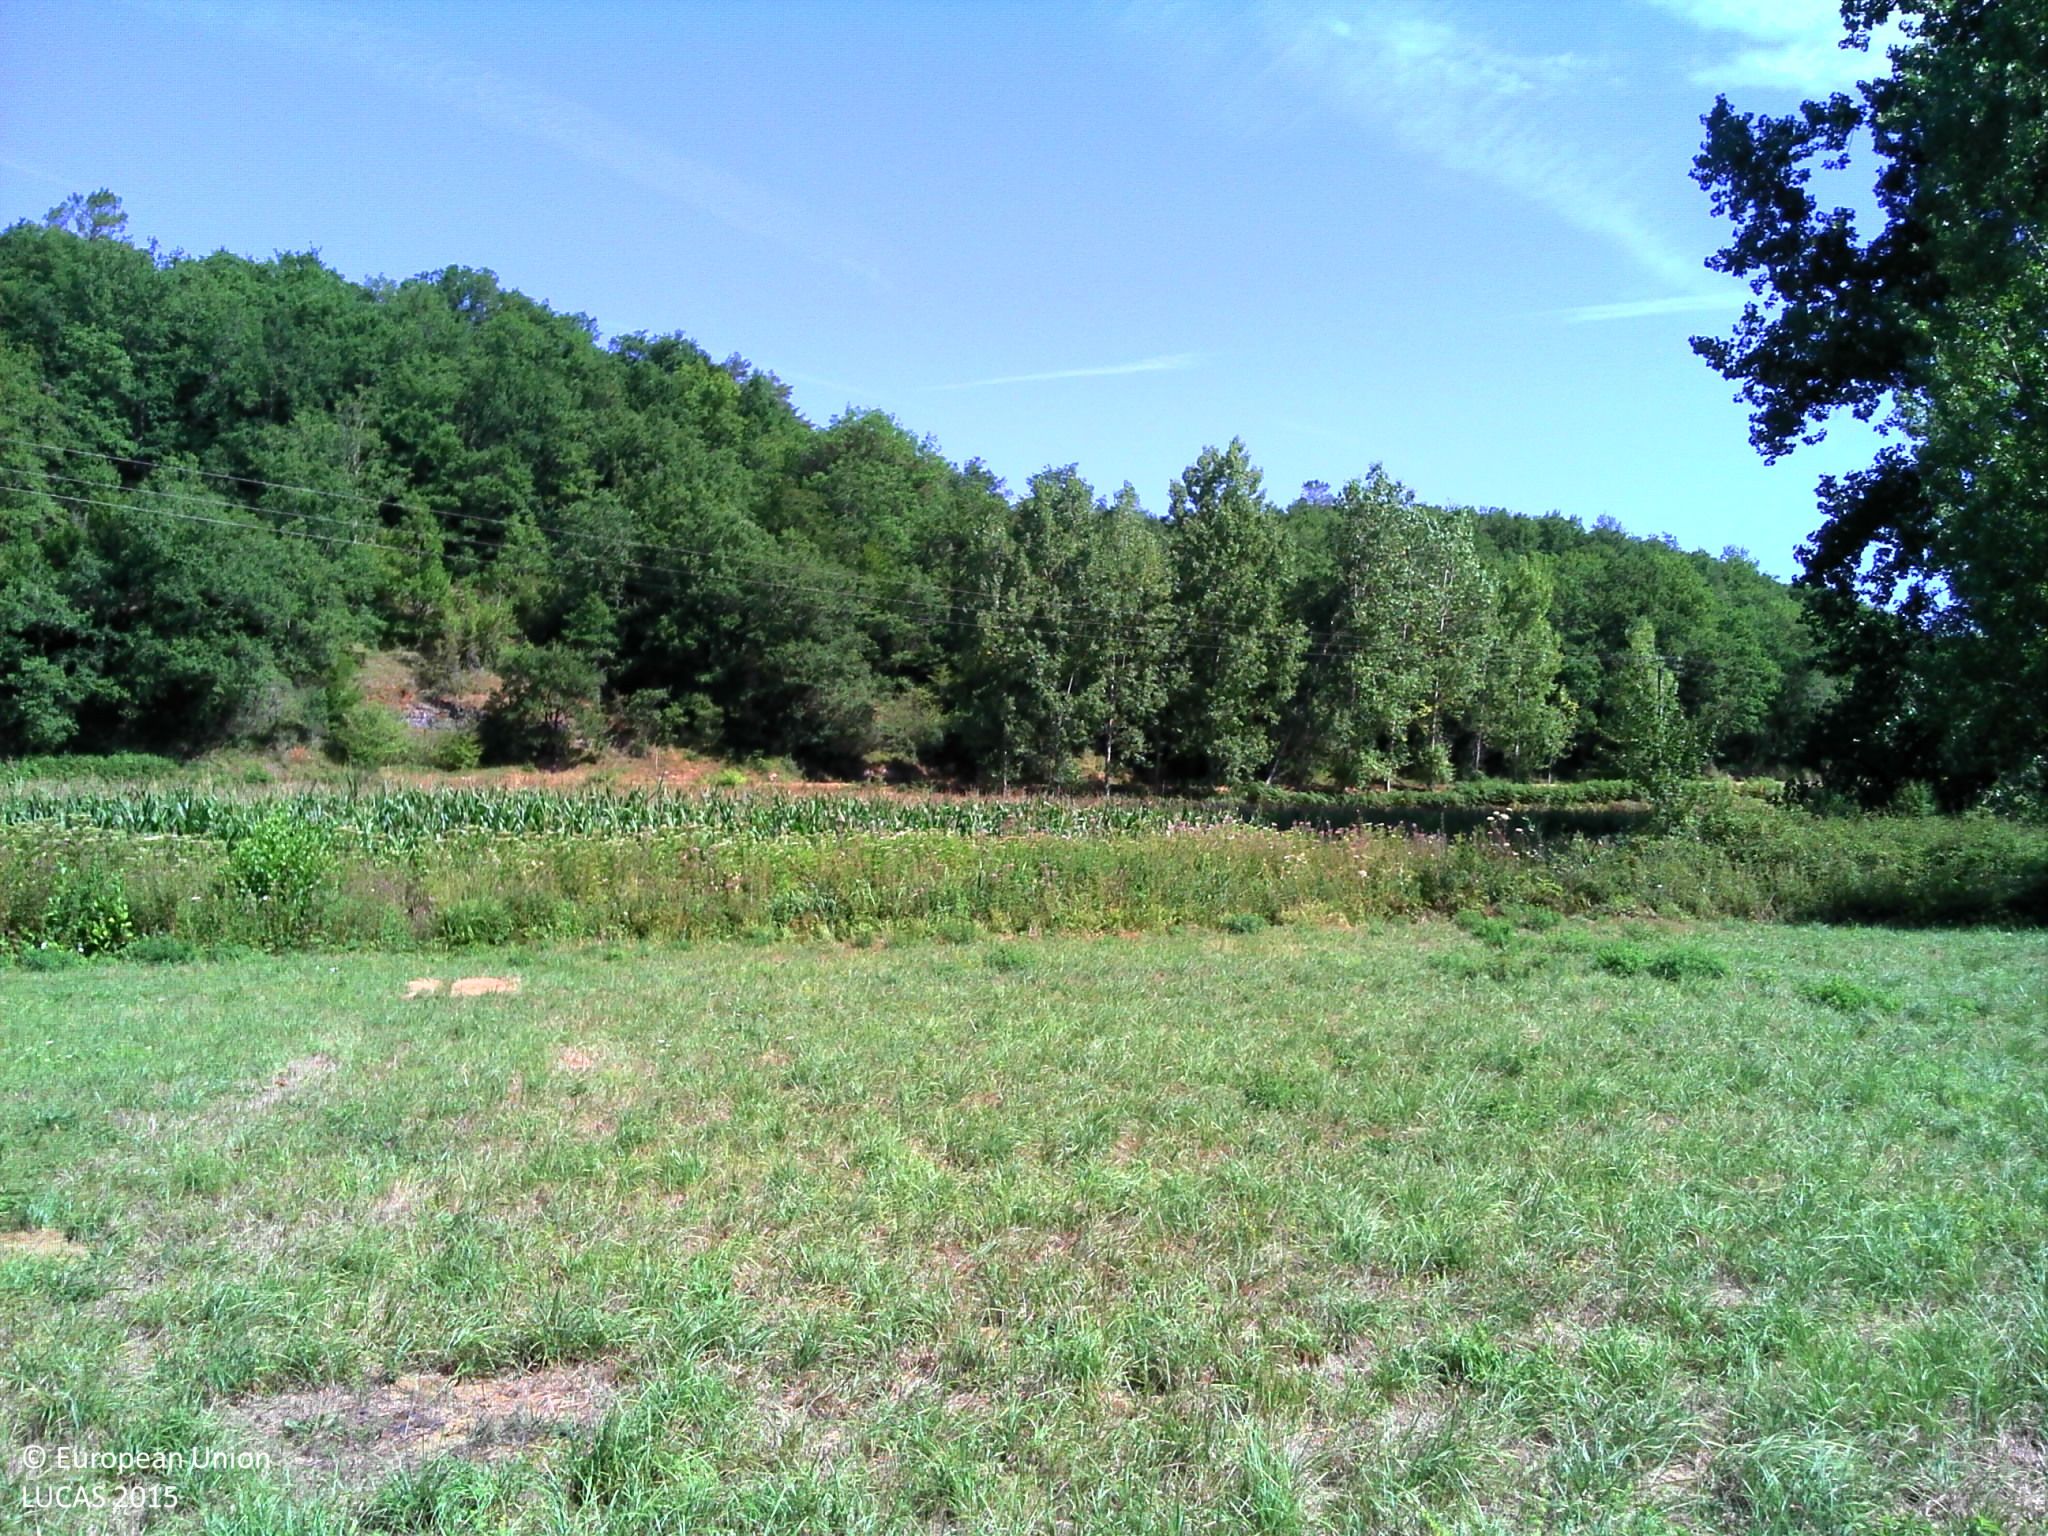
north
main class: Grassland
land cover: Grassland without tree/shrub cover
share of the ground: > 75 %
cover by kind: herbaceous plants 100 %
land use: Agriculture (excluding fallow land and kitchen gardens)
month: July
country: FR
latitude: 44.9717
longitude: 1.1818
